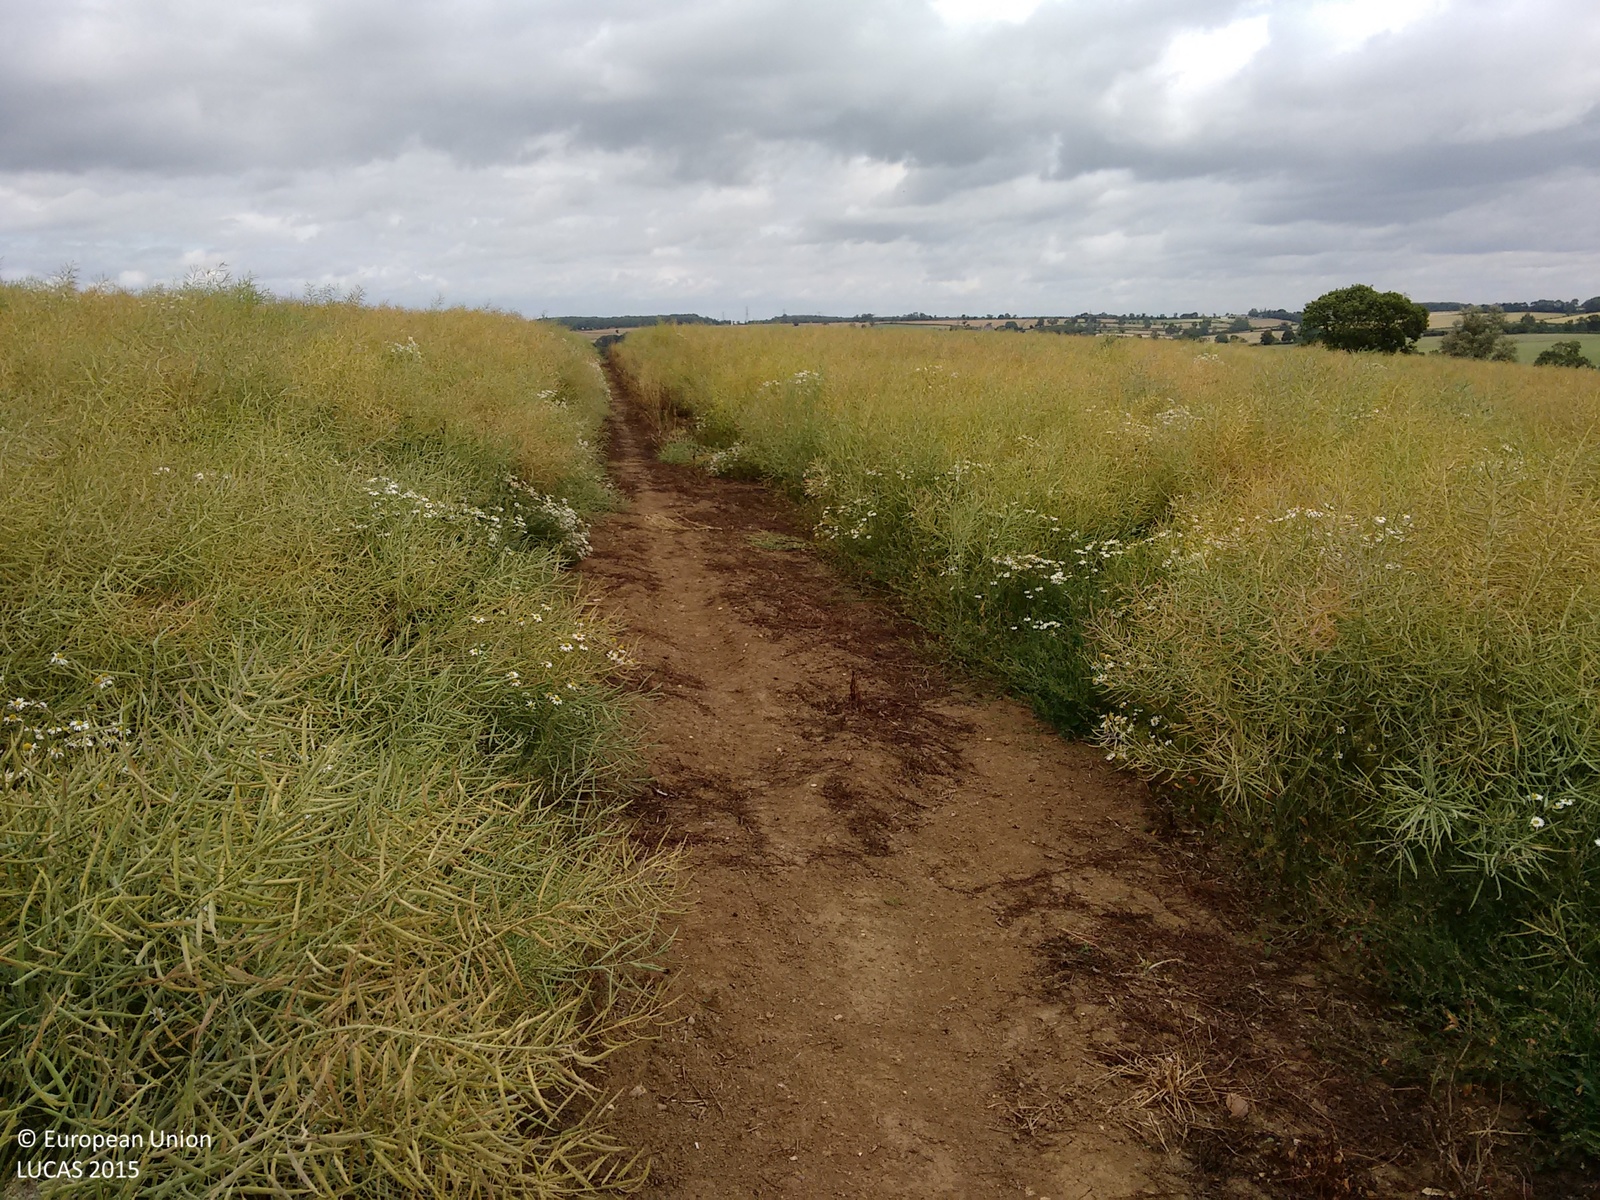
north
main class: Cropland
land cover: Rape and turnip rape
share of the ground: > 75 %
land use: Agriculture (excluding fallow land and kitchen gardens)
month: July
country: GB
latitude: 52.6863
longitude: -0.9462
